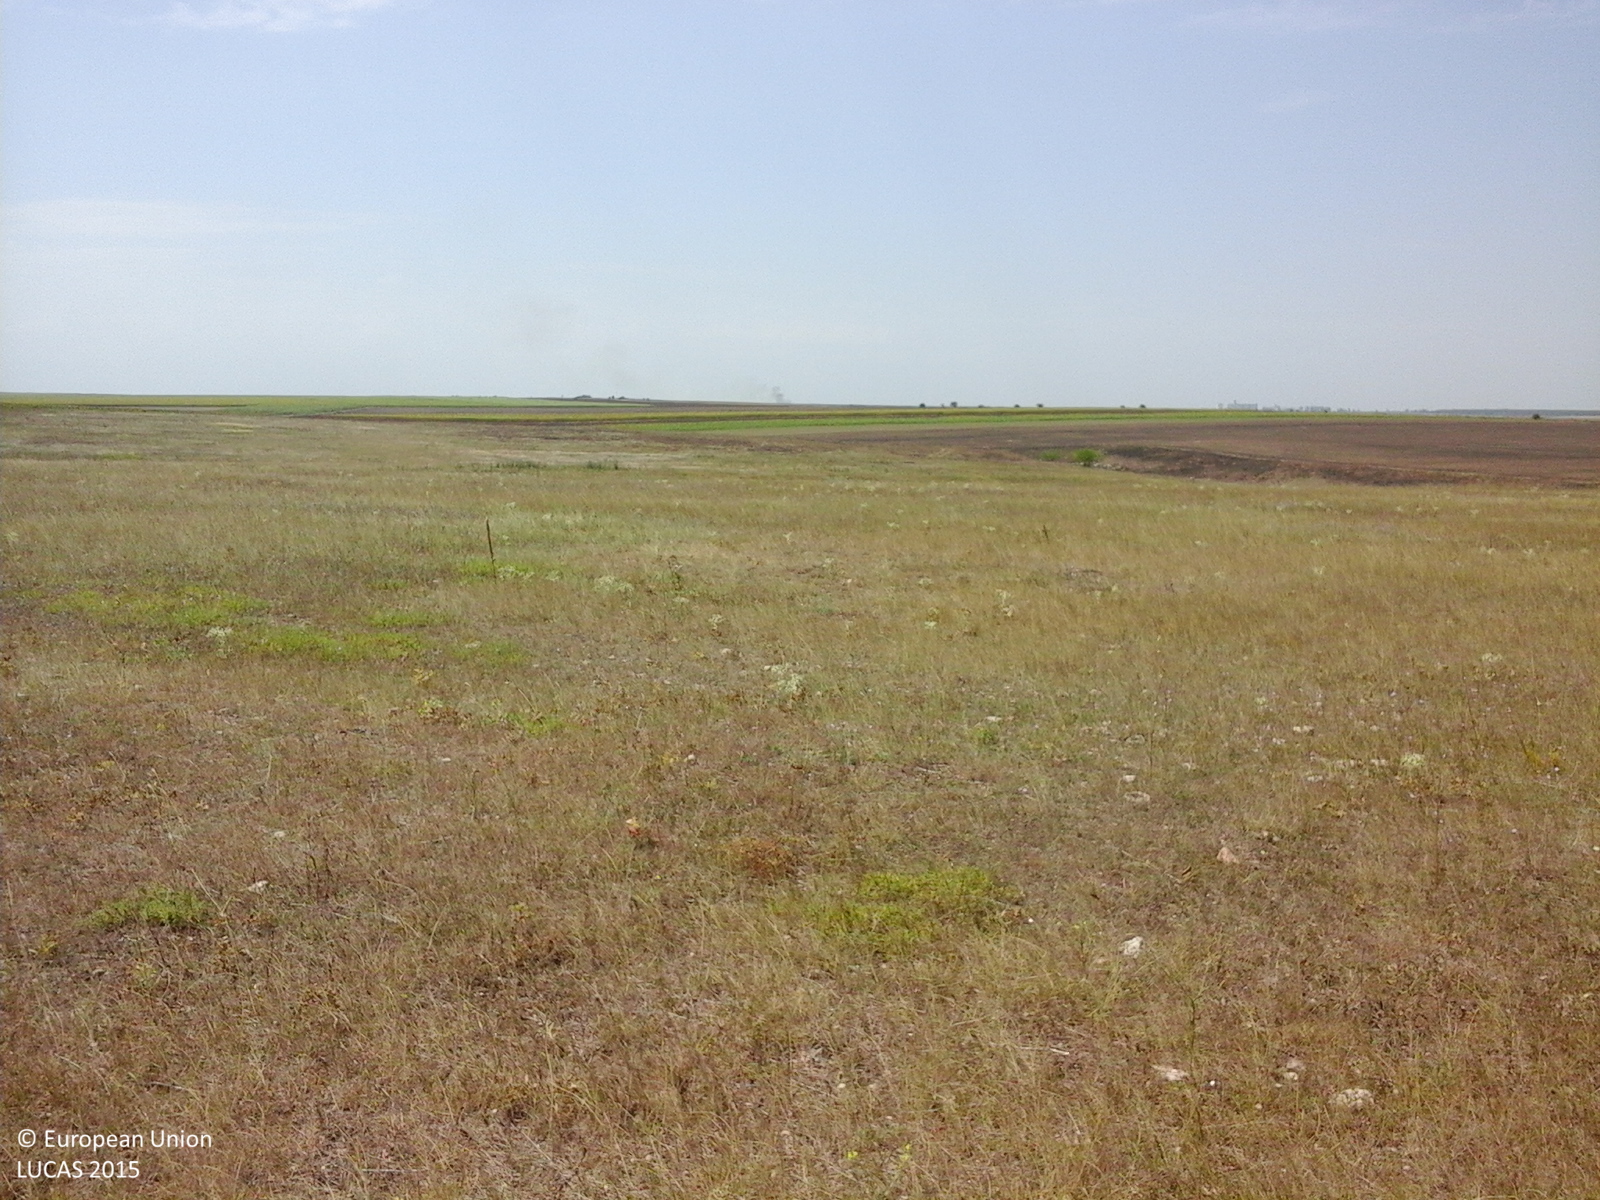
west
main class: Grassland
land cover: Grassland without tree/shrub cover
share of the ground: > 75 %
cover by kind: herbaceous plants 100 %
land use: Agriculture (excluding fallow land and kitchen gardens)
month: August
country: RO
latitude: 43.7748
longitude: 28.3101
